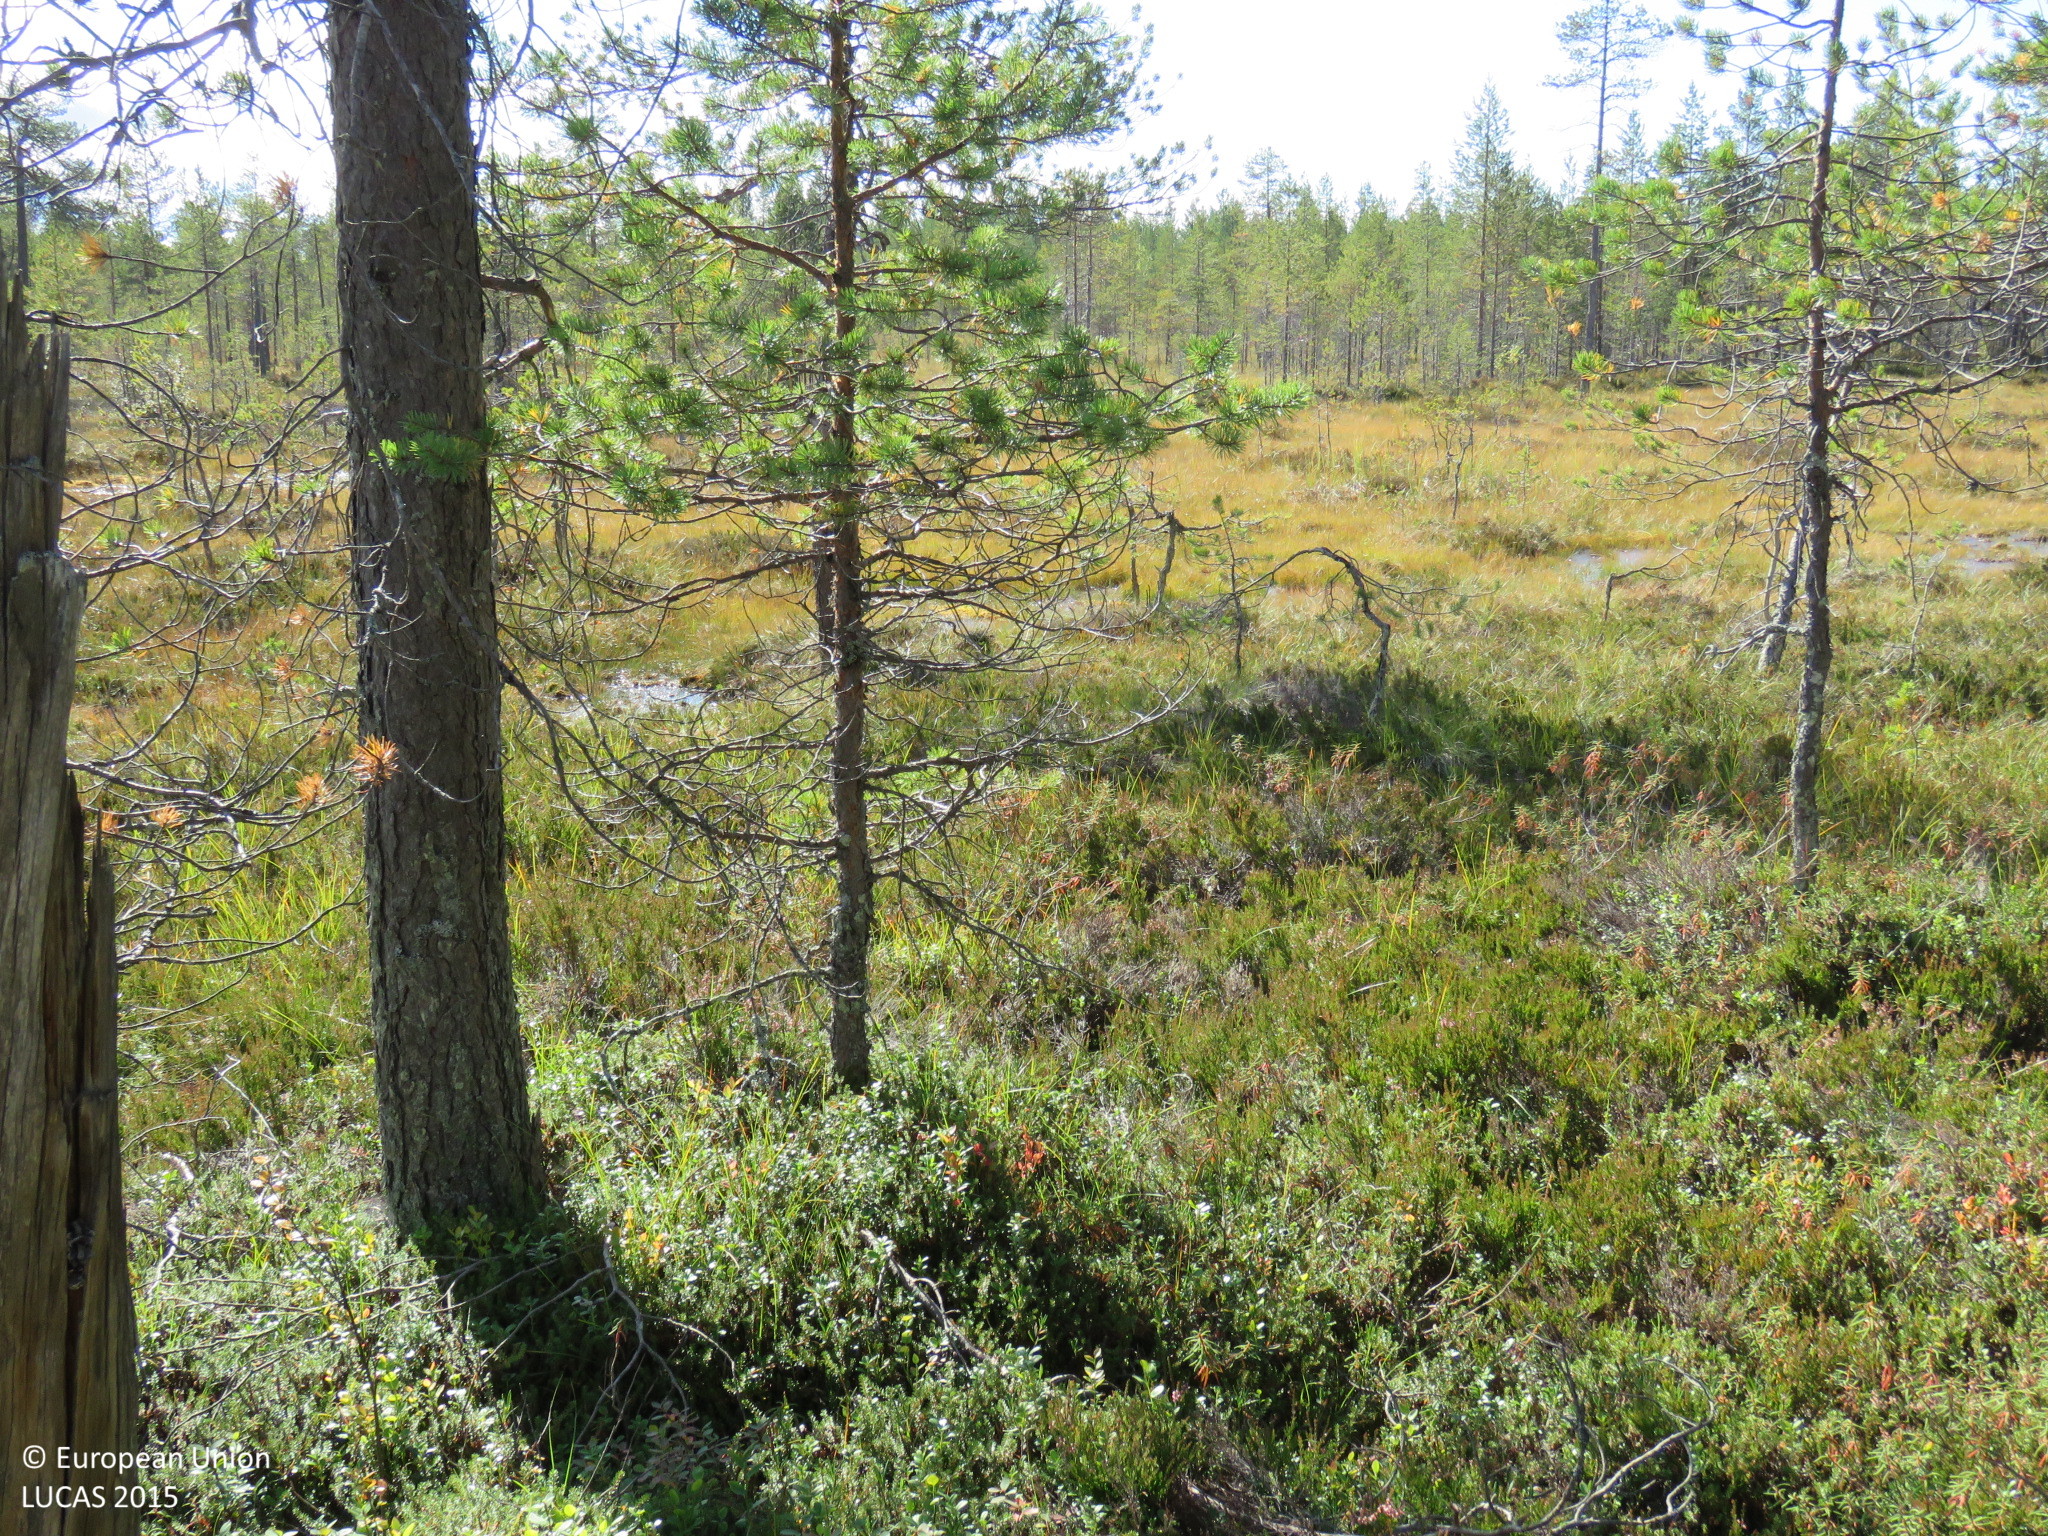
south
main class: Woodland
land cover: Pine dominated coniferous woodland
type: boreal forest
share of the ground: > 75 %
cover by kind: coniferous forest trees 80 %, shrubs 15 %, lichens and mosses 5 %
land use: Forestry
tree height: > 5 m
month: September
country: FI
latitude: 65.3921
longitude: 27.4551
